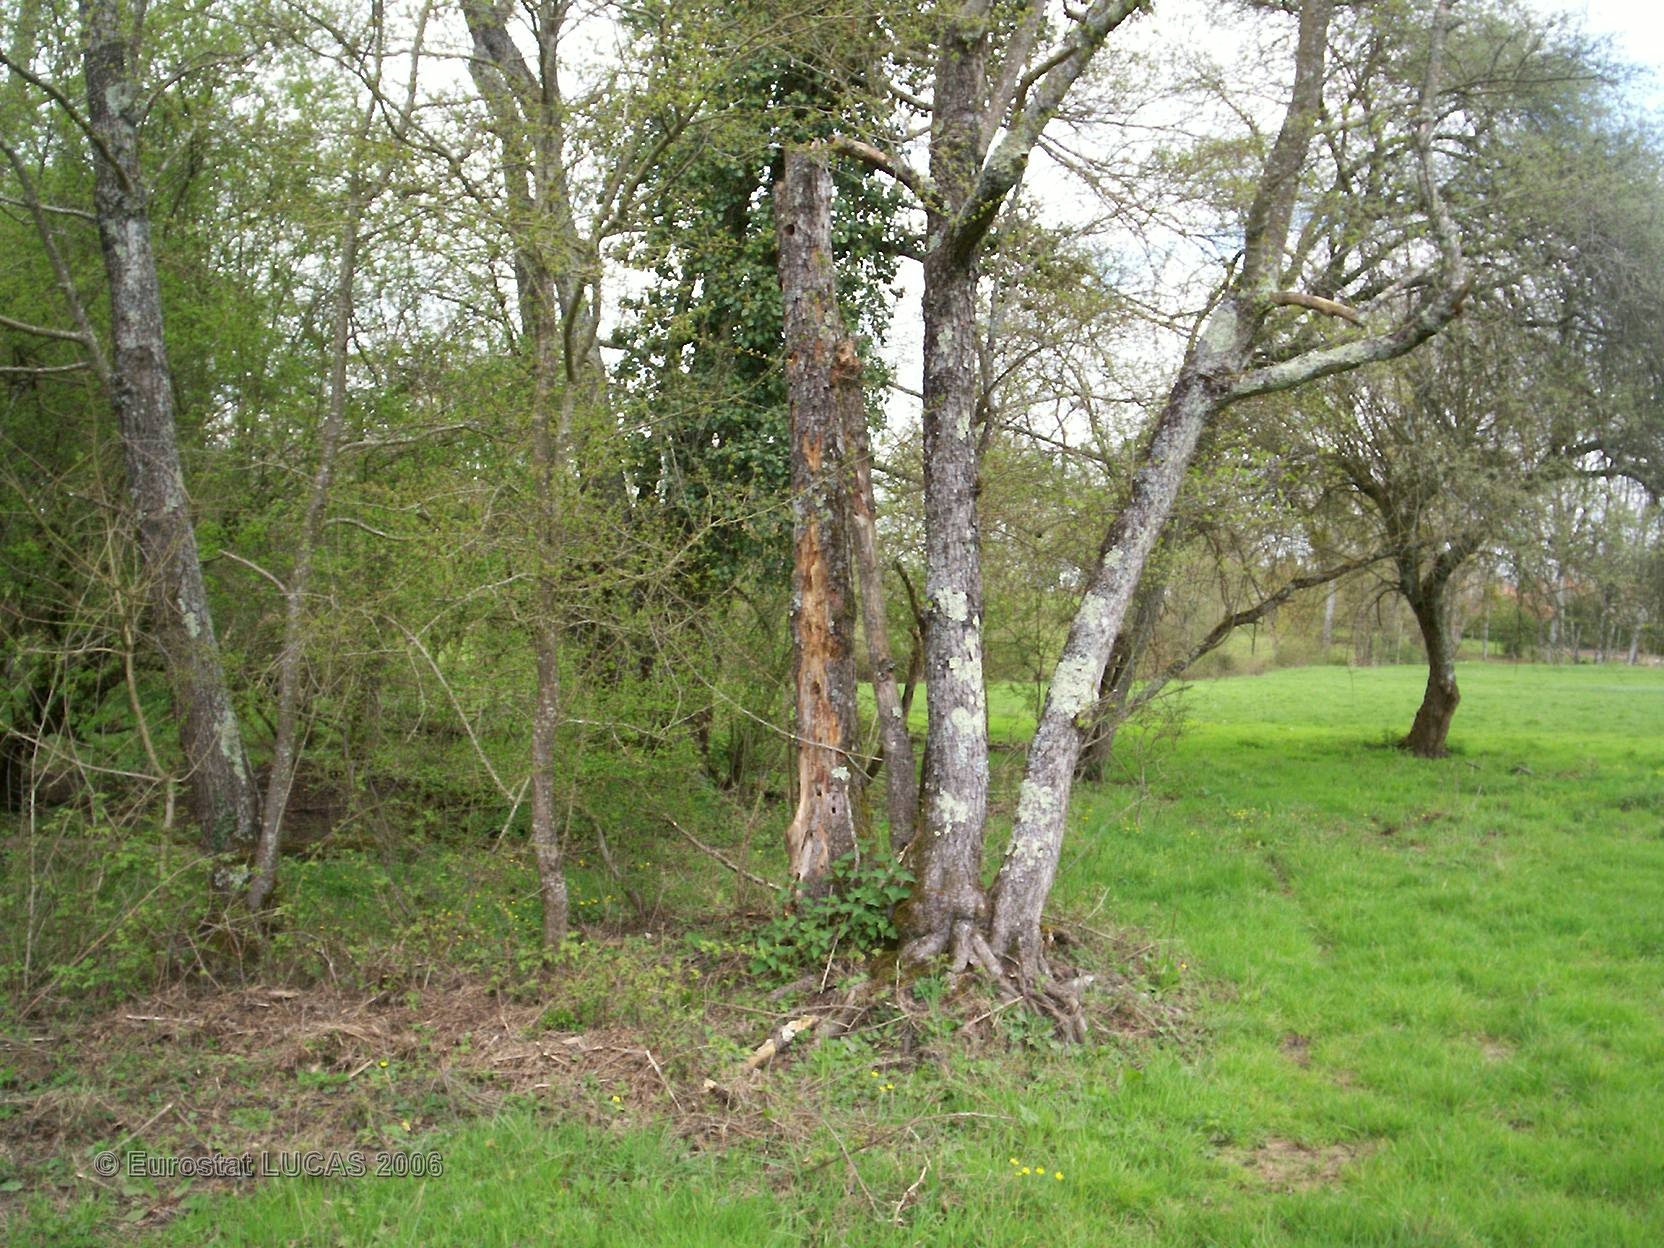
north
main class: Grassland
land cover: Grassland without tree/shrub cover
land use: Agriculture (excluding fallow land and kitchen gardens)
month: April
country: FR
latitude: 46.2384
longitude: 0.5301
